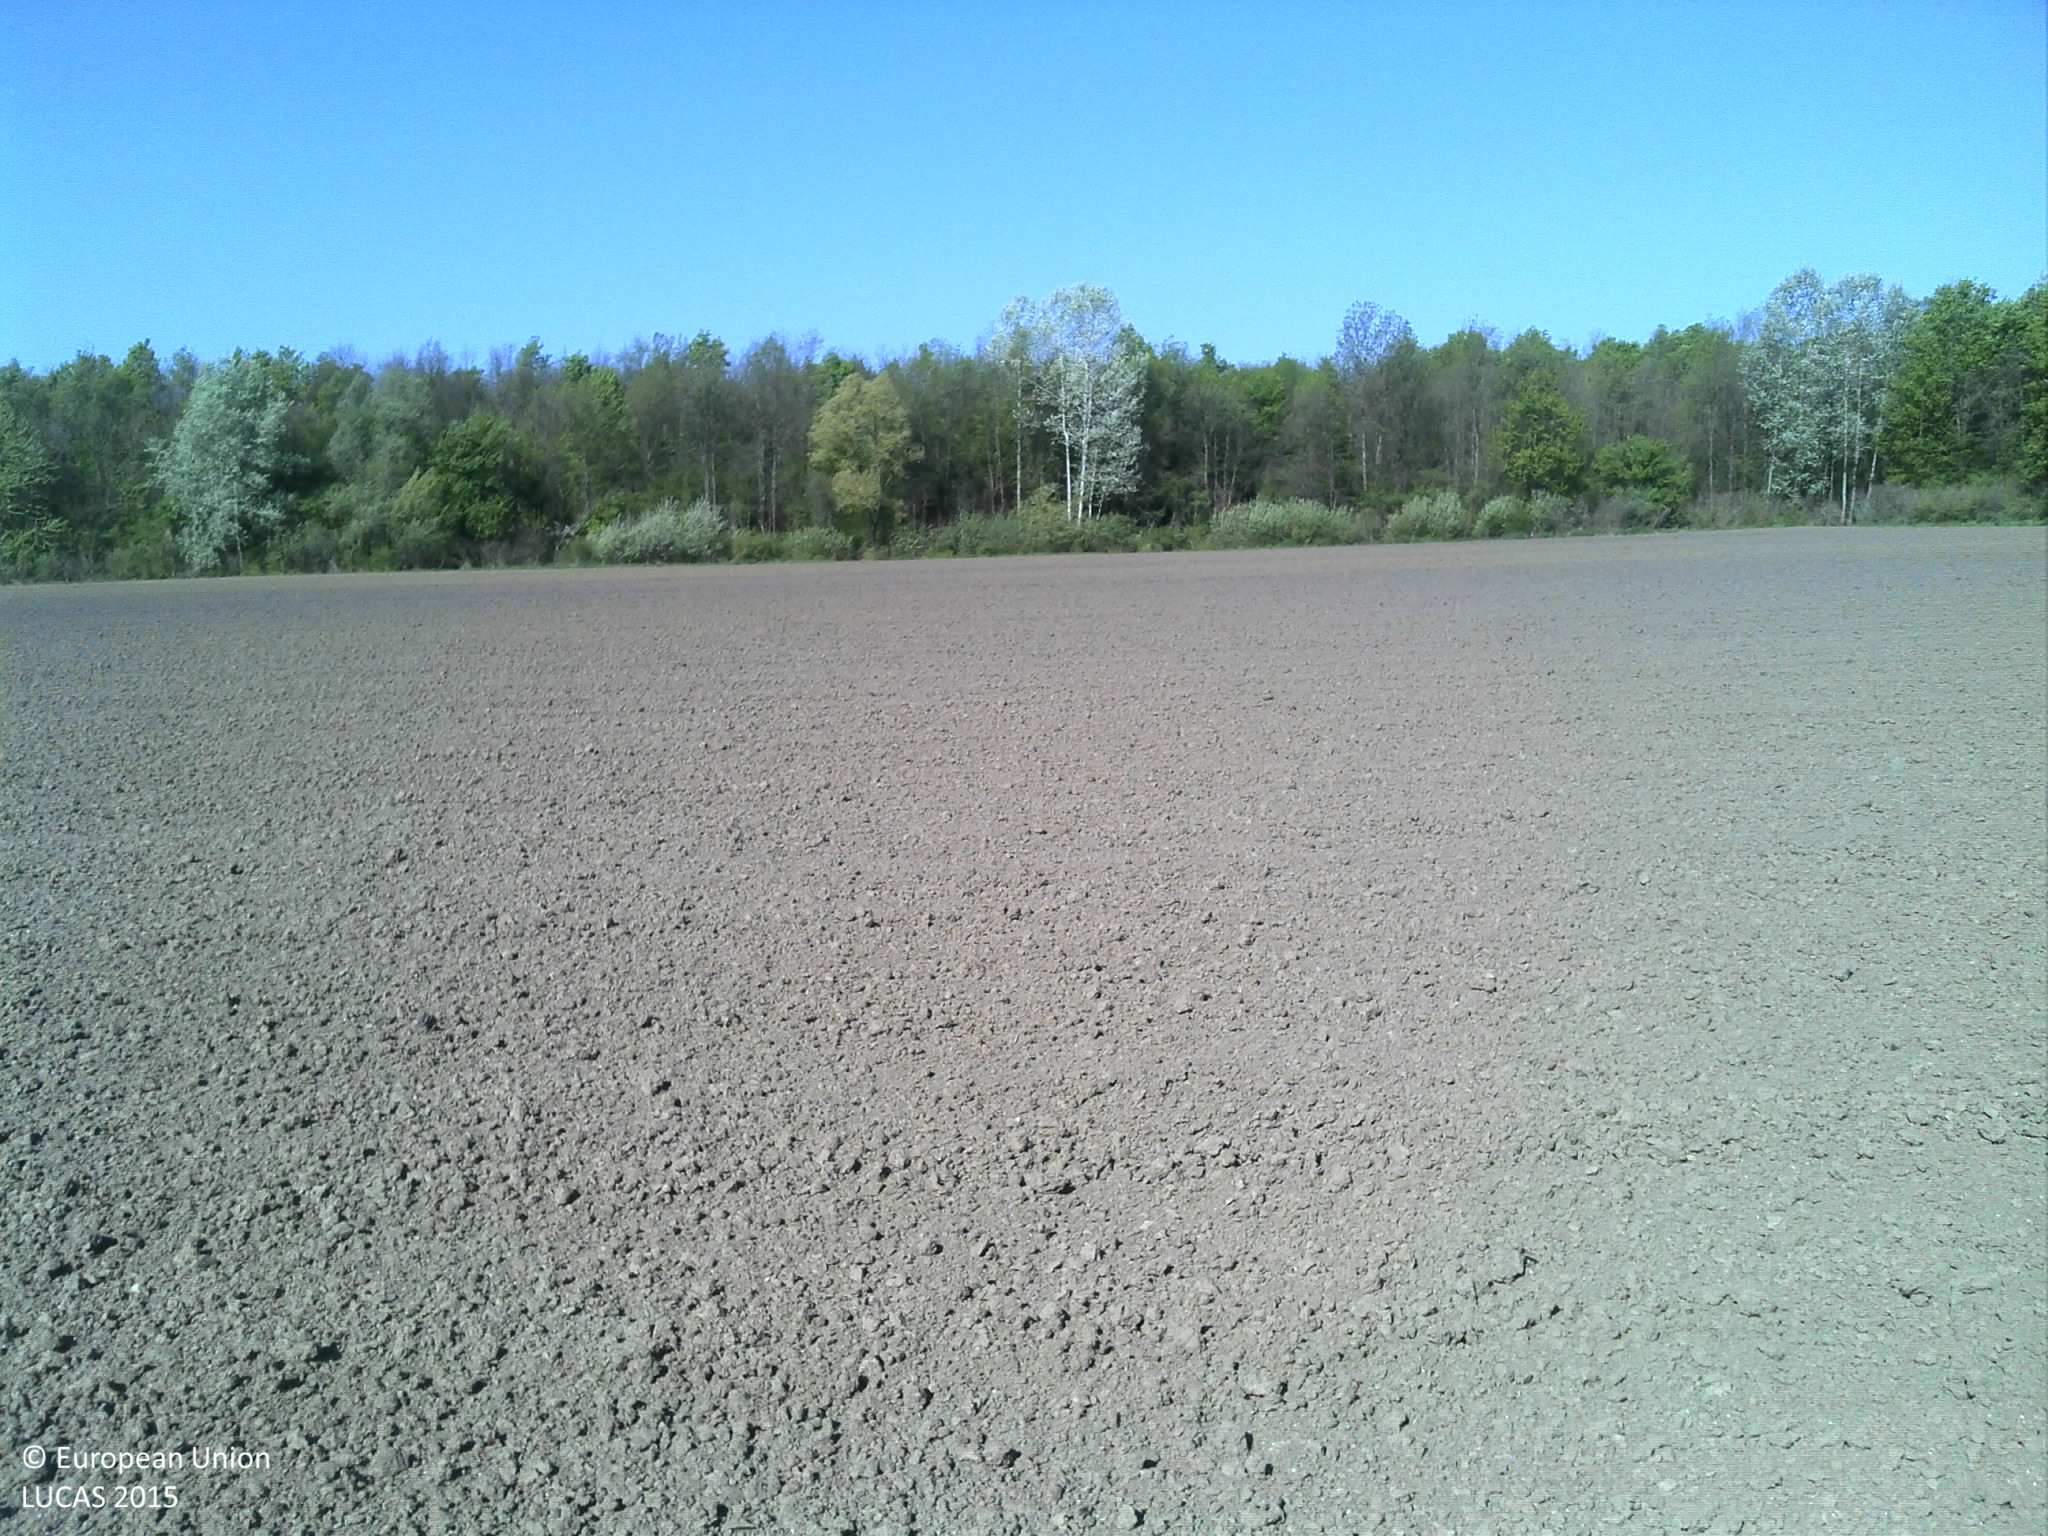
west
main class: Cropland
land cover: Soya
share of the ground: < 10 %
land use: Agriculture (excluding fallow land and kitchen gardens)
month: April
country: HR
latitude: 45.2253
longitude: 18.6025
